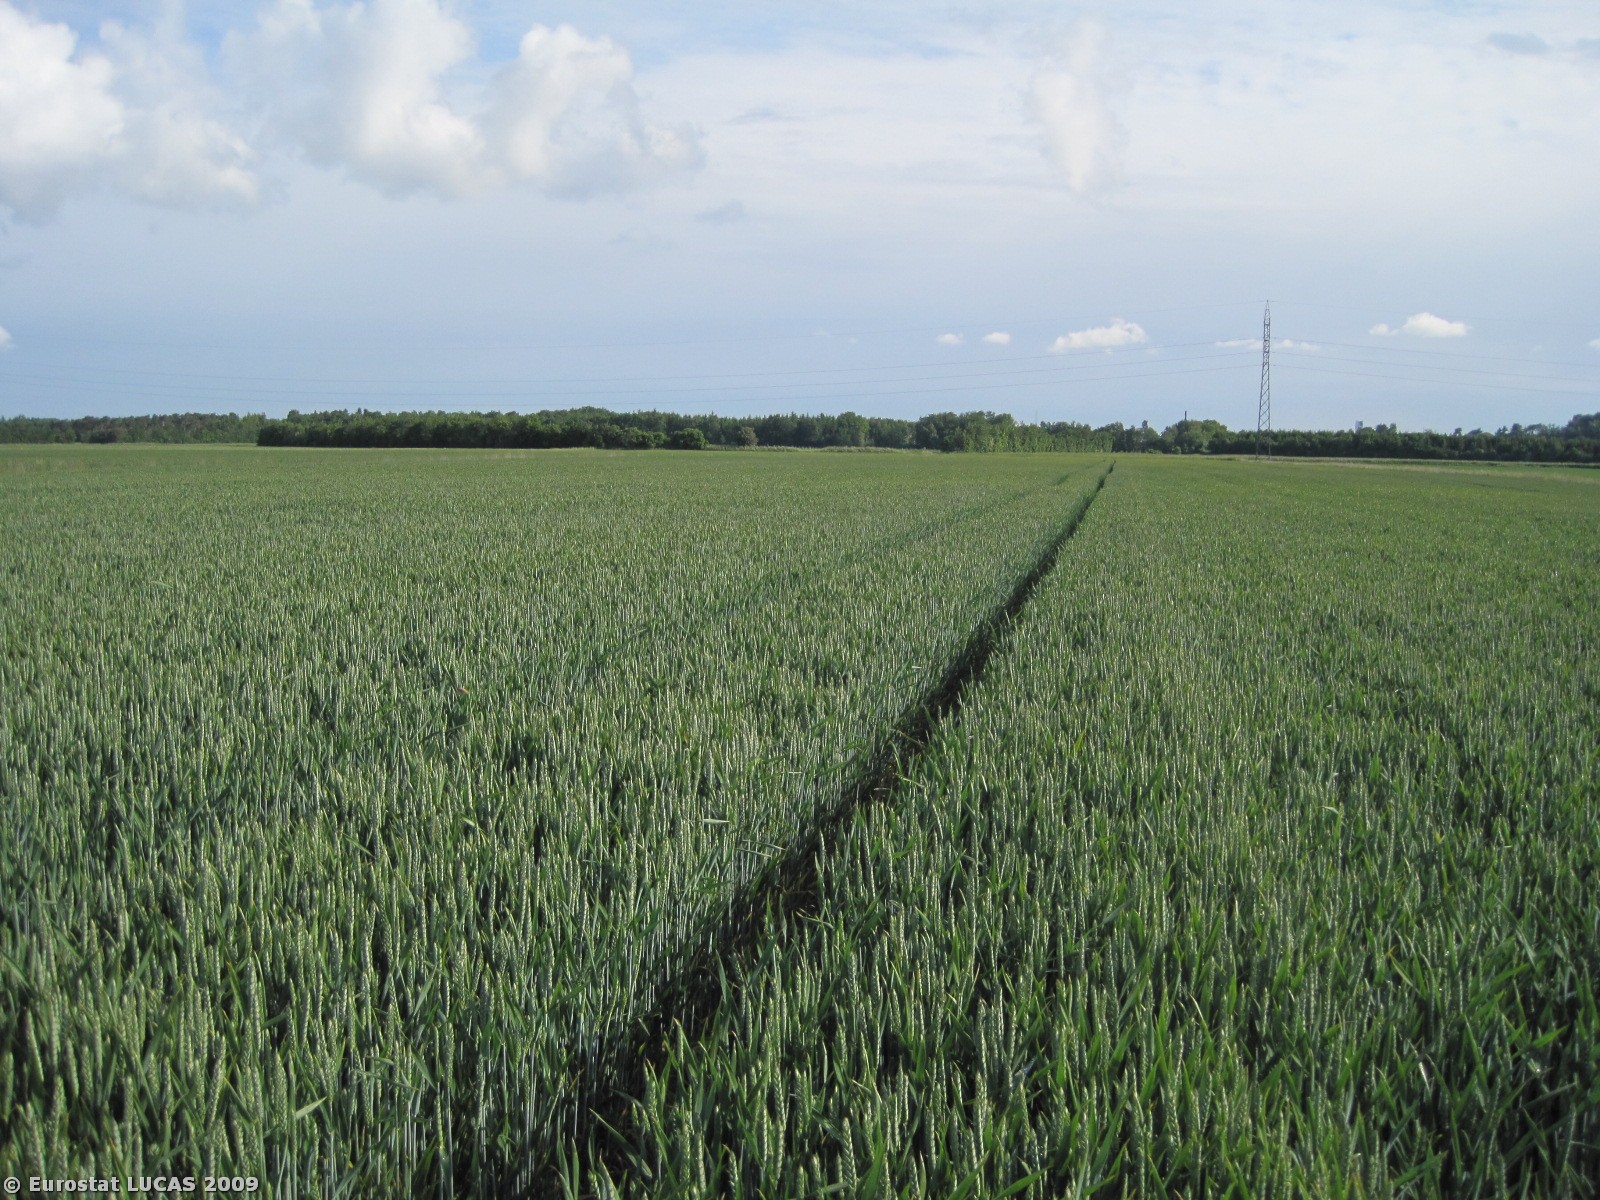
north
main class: Cropland
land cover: Common wheat
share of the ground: > 75 %
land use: Agriculture (excluding fallow land and kitchen gardens)
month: June
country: DK
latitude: 57.0506
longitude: 10.1152
